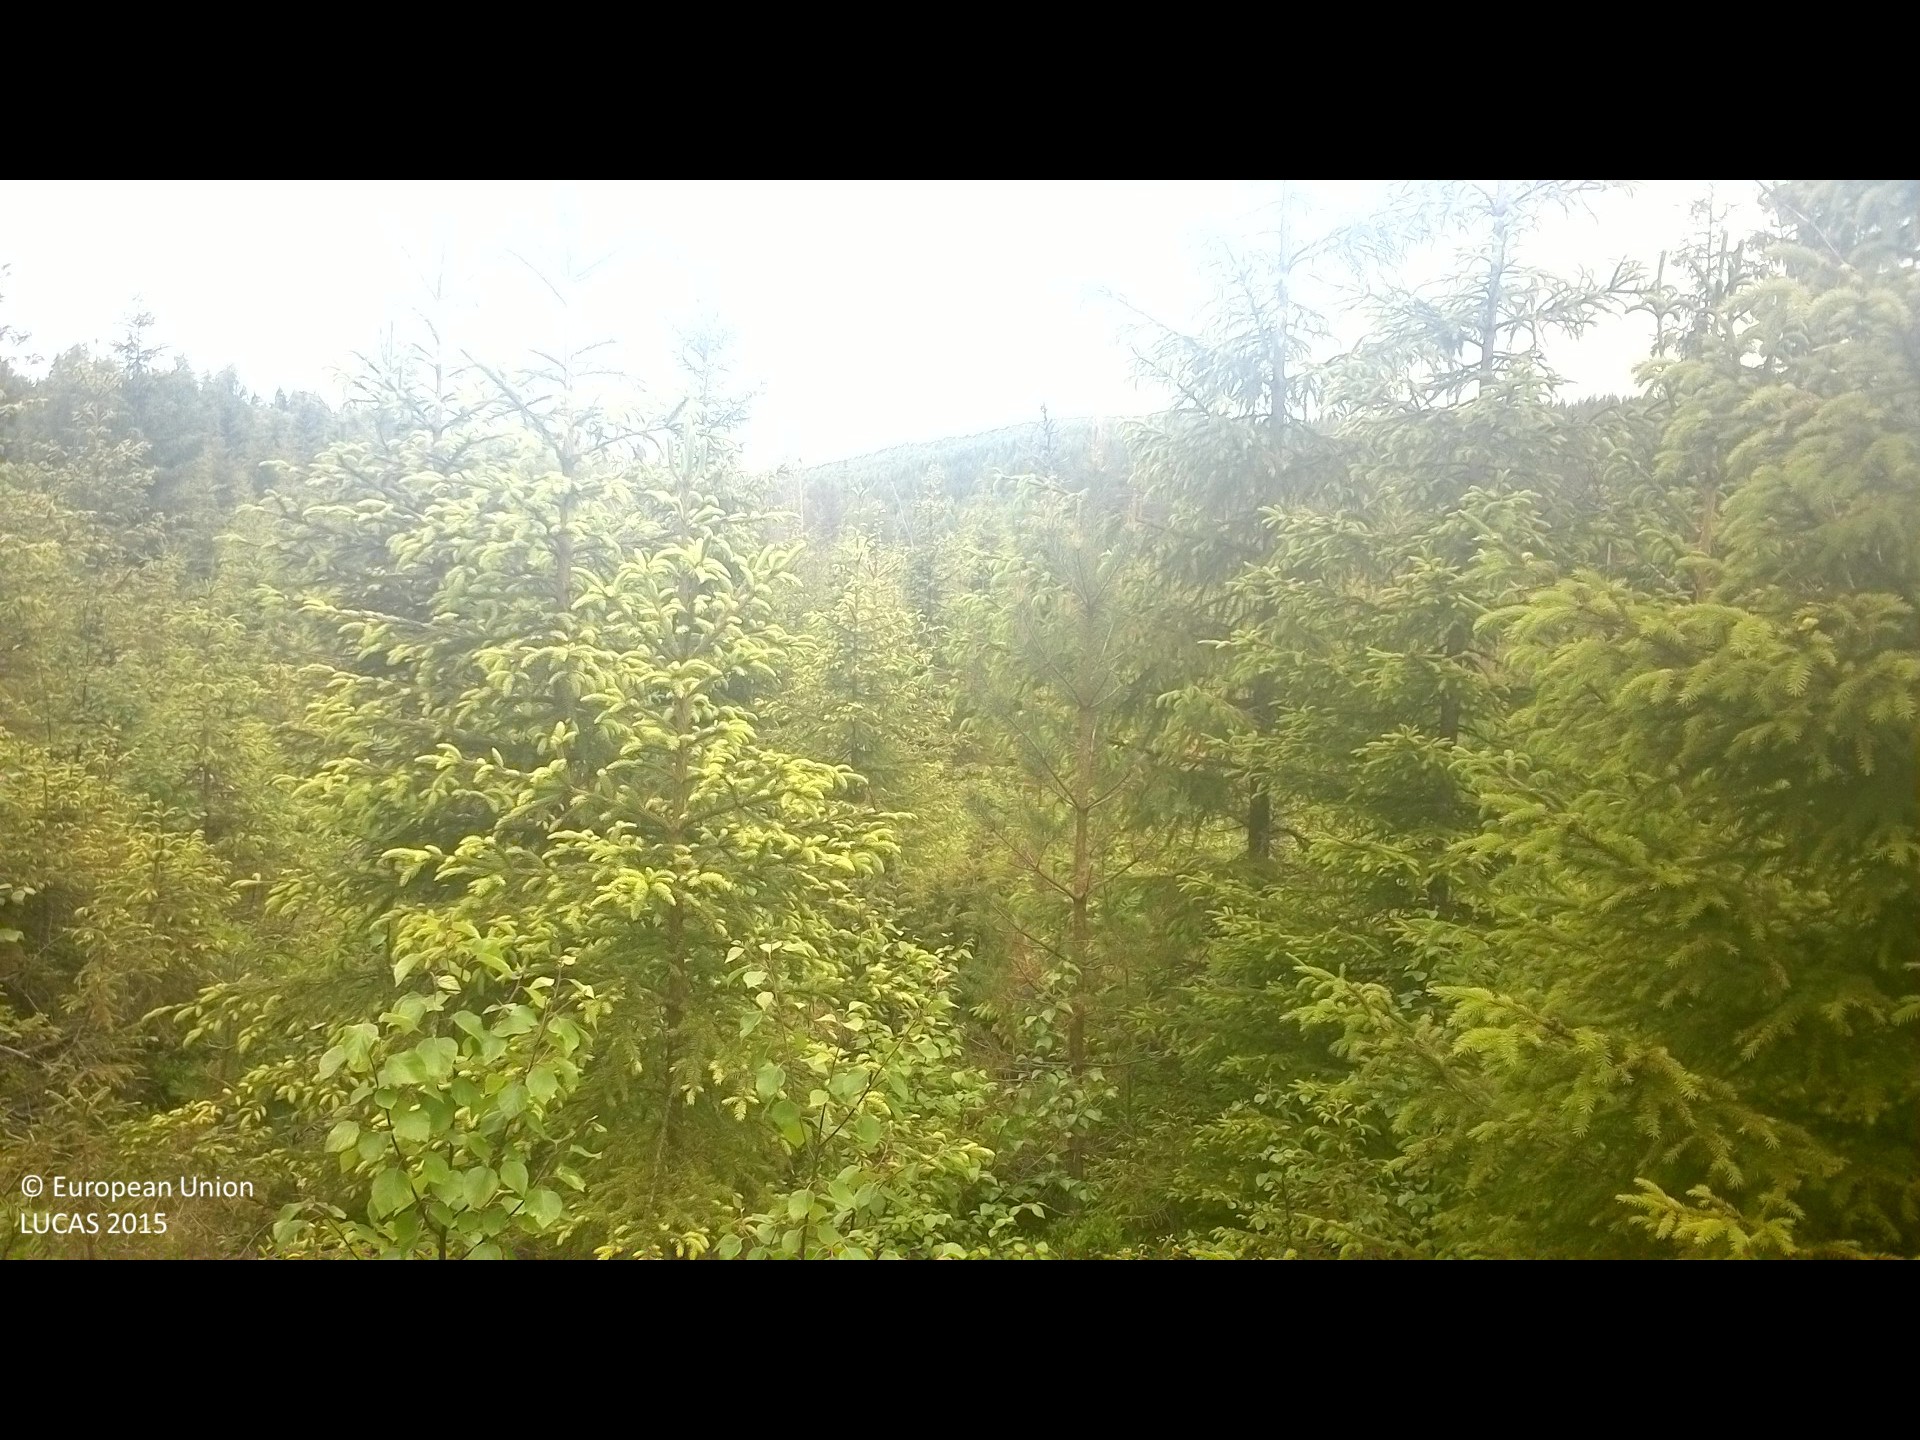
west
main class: Woodland
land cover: Spruce dominated mixed woodland
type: boreal forest
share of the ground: 25 - 50 %
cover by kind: coniferous forest trees 30 %, shrubs 30 %, lichens and mosses 25 %, broadleaved forest trees 15 %
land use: Forestry
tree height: < 5 m
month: June
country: SE
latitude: 61.9917
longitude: 16.7202
